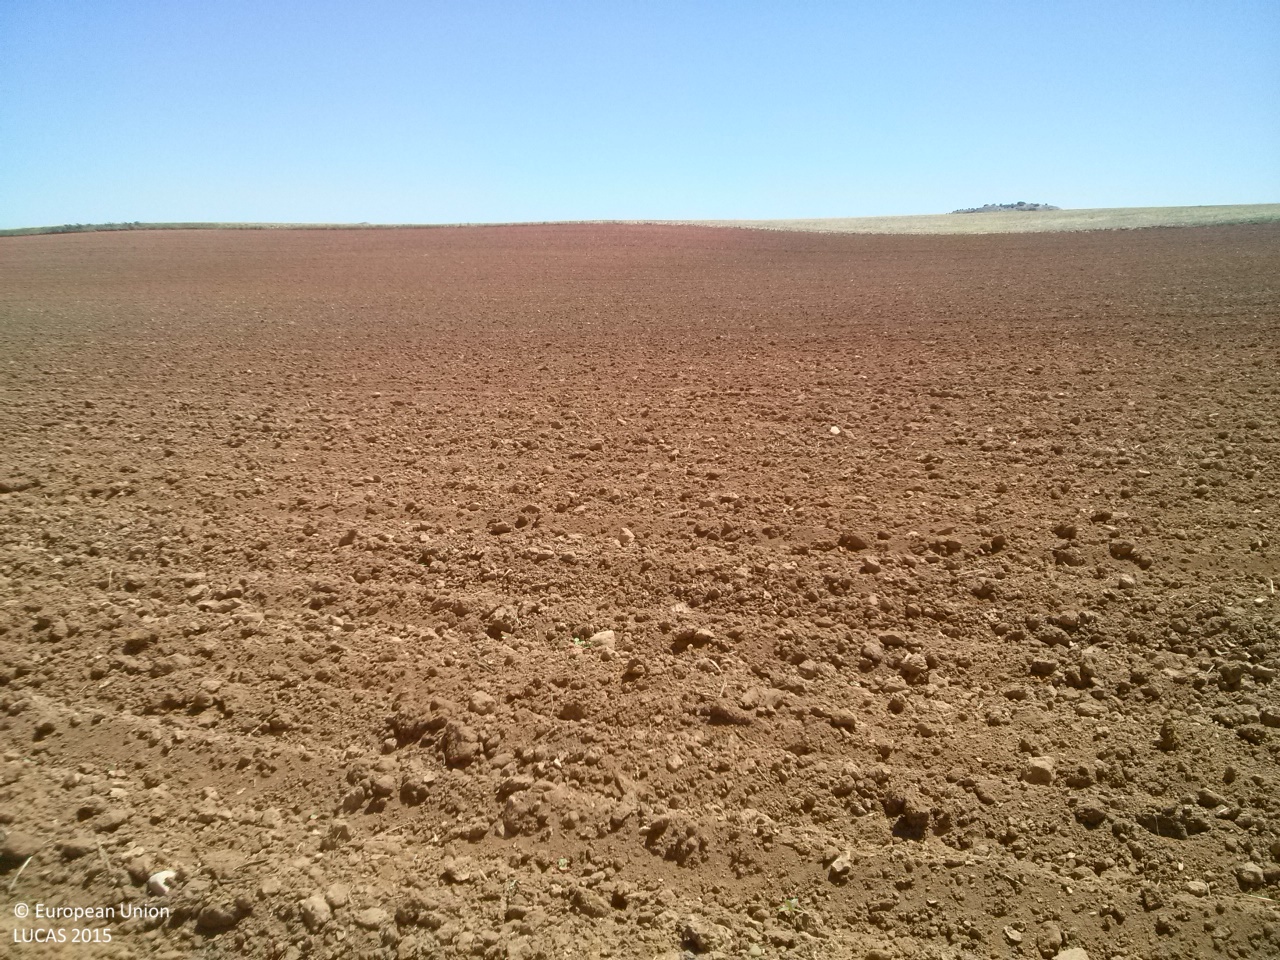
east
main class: Cropland
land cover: Sunflower
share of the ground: < 10 %
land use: Agriculture (excluding fallow land and kitchen gardens)
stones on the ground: < 10 %
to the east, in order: Sunflower; Grass margins; Spontaneously vegetated surfaces
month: May
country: ES
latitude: 40.2361
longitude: -2.7533
